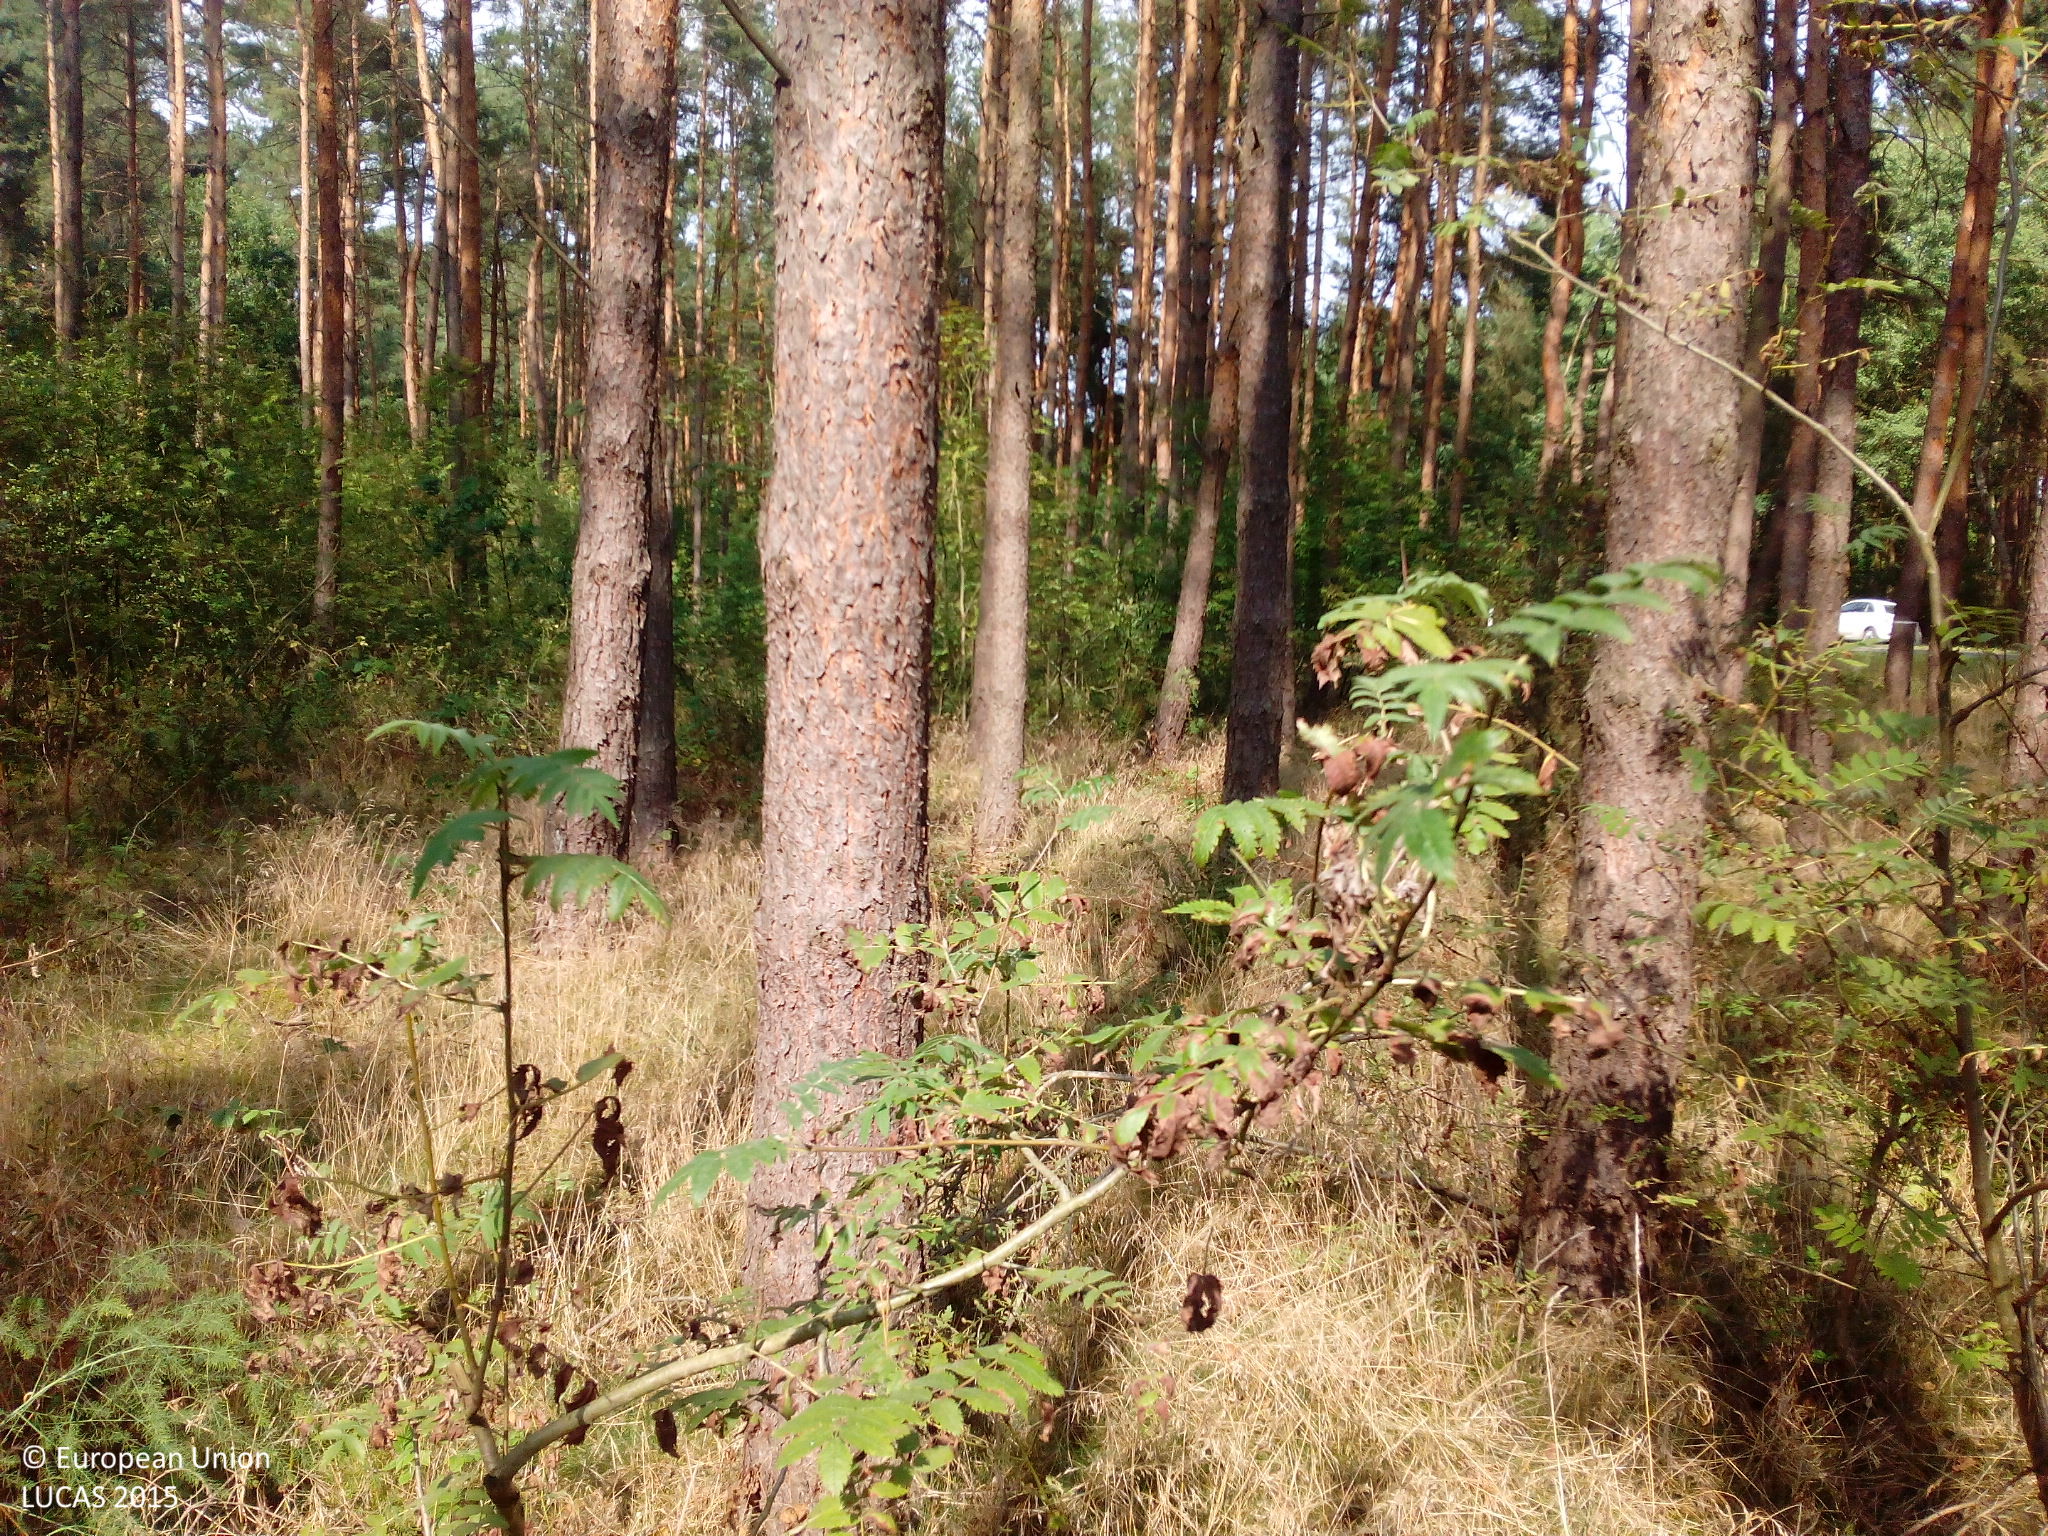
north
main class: Woodland
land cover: Pine dominated coniferous woodland
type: hemiboreal forest and nemoral coniferous forest and mixed broadleaved-coniferous forest
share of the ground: 50 - 75 %
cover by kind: coniferous forest trees 60 %, shrubs 20 %, herbaceous plants 10 %, lichens and mosses 10 %
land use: Forestry
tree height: > 5 m
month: August
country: DE
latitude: 52.8681
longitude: 11.7375
